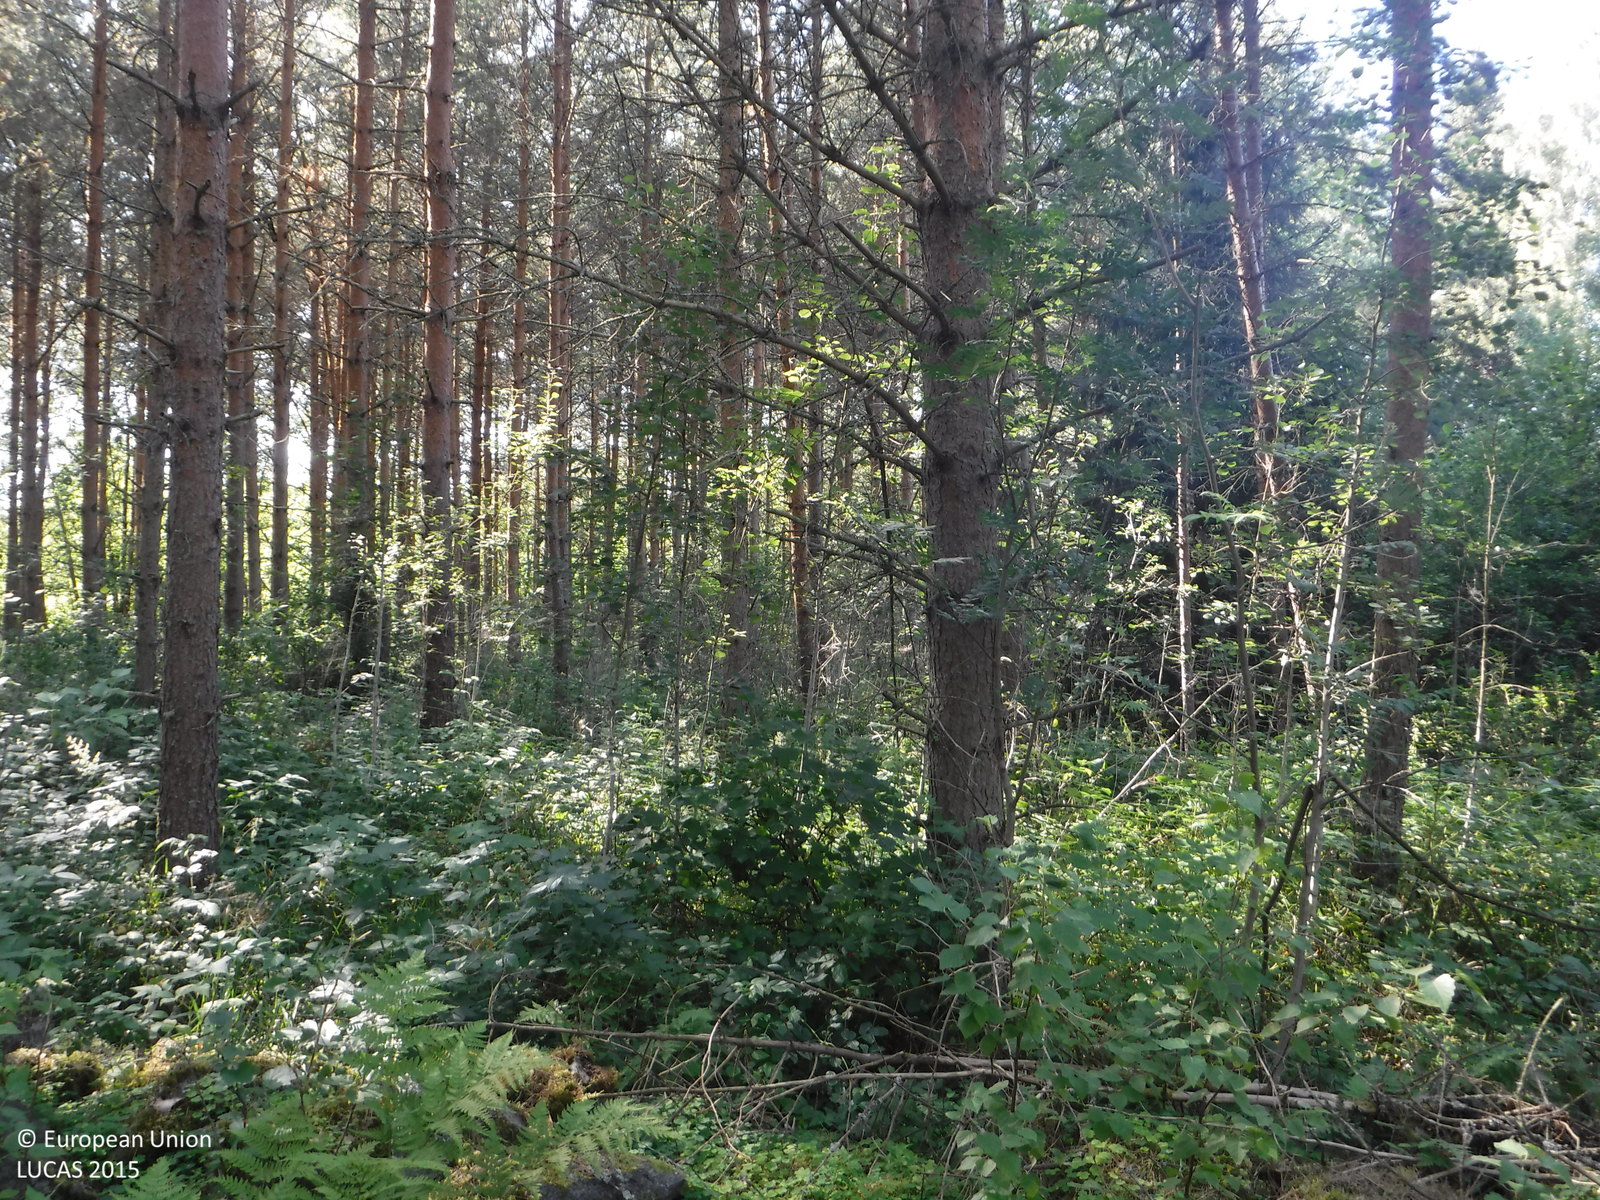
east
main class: Woodland
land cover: Pine dominated coniferous woodland
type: boreal forest
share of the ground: 50 - 75 %
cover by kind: coniferous forest trees 65 %, shrubs 30 %, herbaceous plants 5 %
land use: Forestry
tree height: > 5 m
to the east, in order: Pine dominated coniferous woodland; Dry stone walls; Pine dominated coniferous woodland; Other mixed woodland; Tracks; Broadleaved woodland; Ditches and canals; Broadleaved woodland; Shrubland with sparse tree cover; Pine dominated mixed woodland; Shrubland with sparse tree cover; Pine dominated coniferous woodland
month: August
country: FI
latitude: 61.0823
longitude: 21.4165
